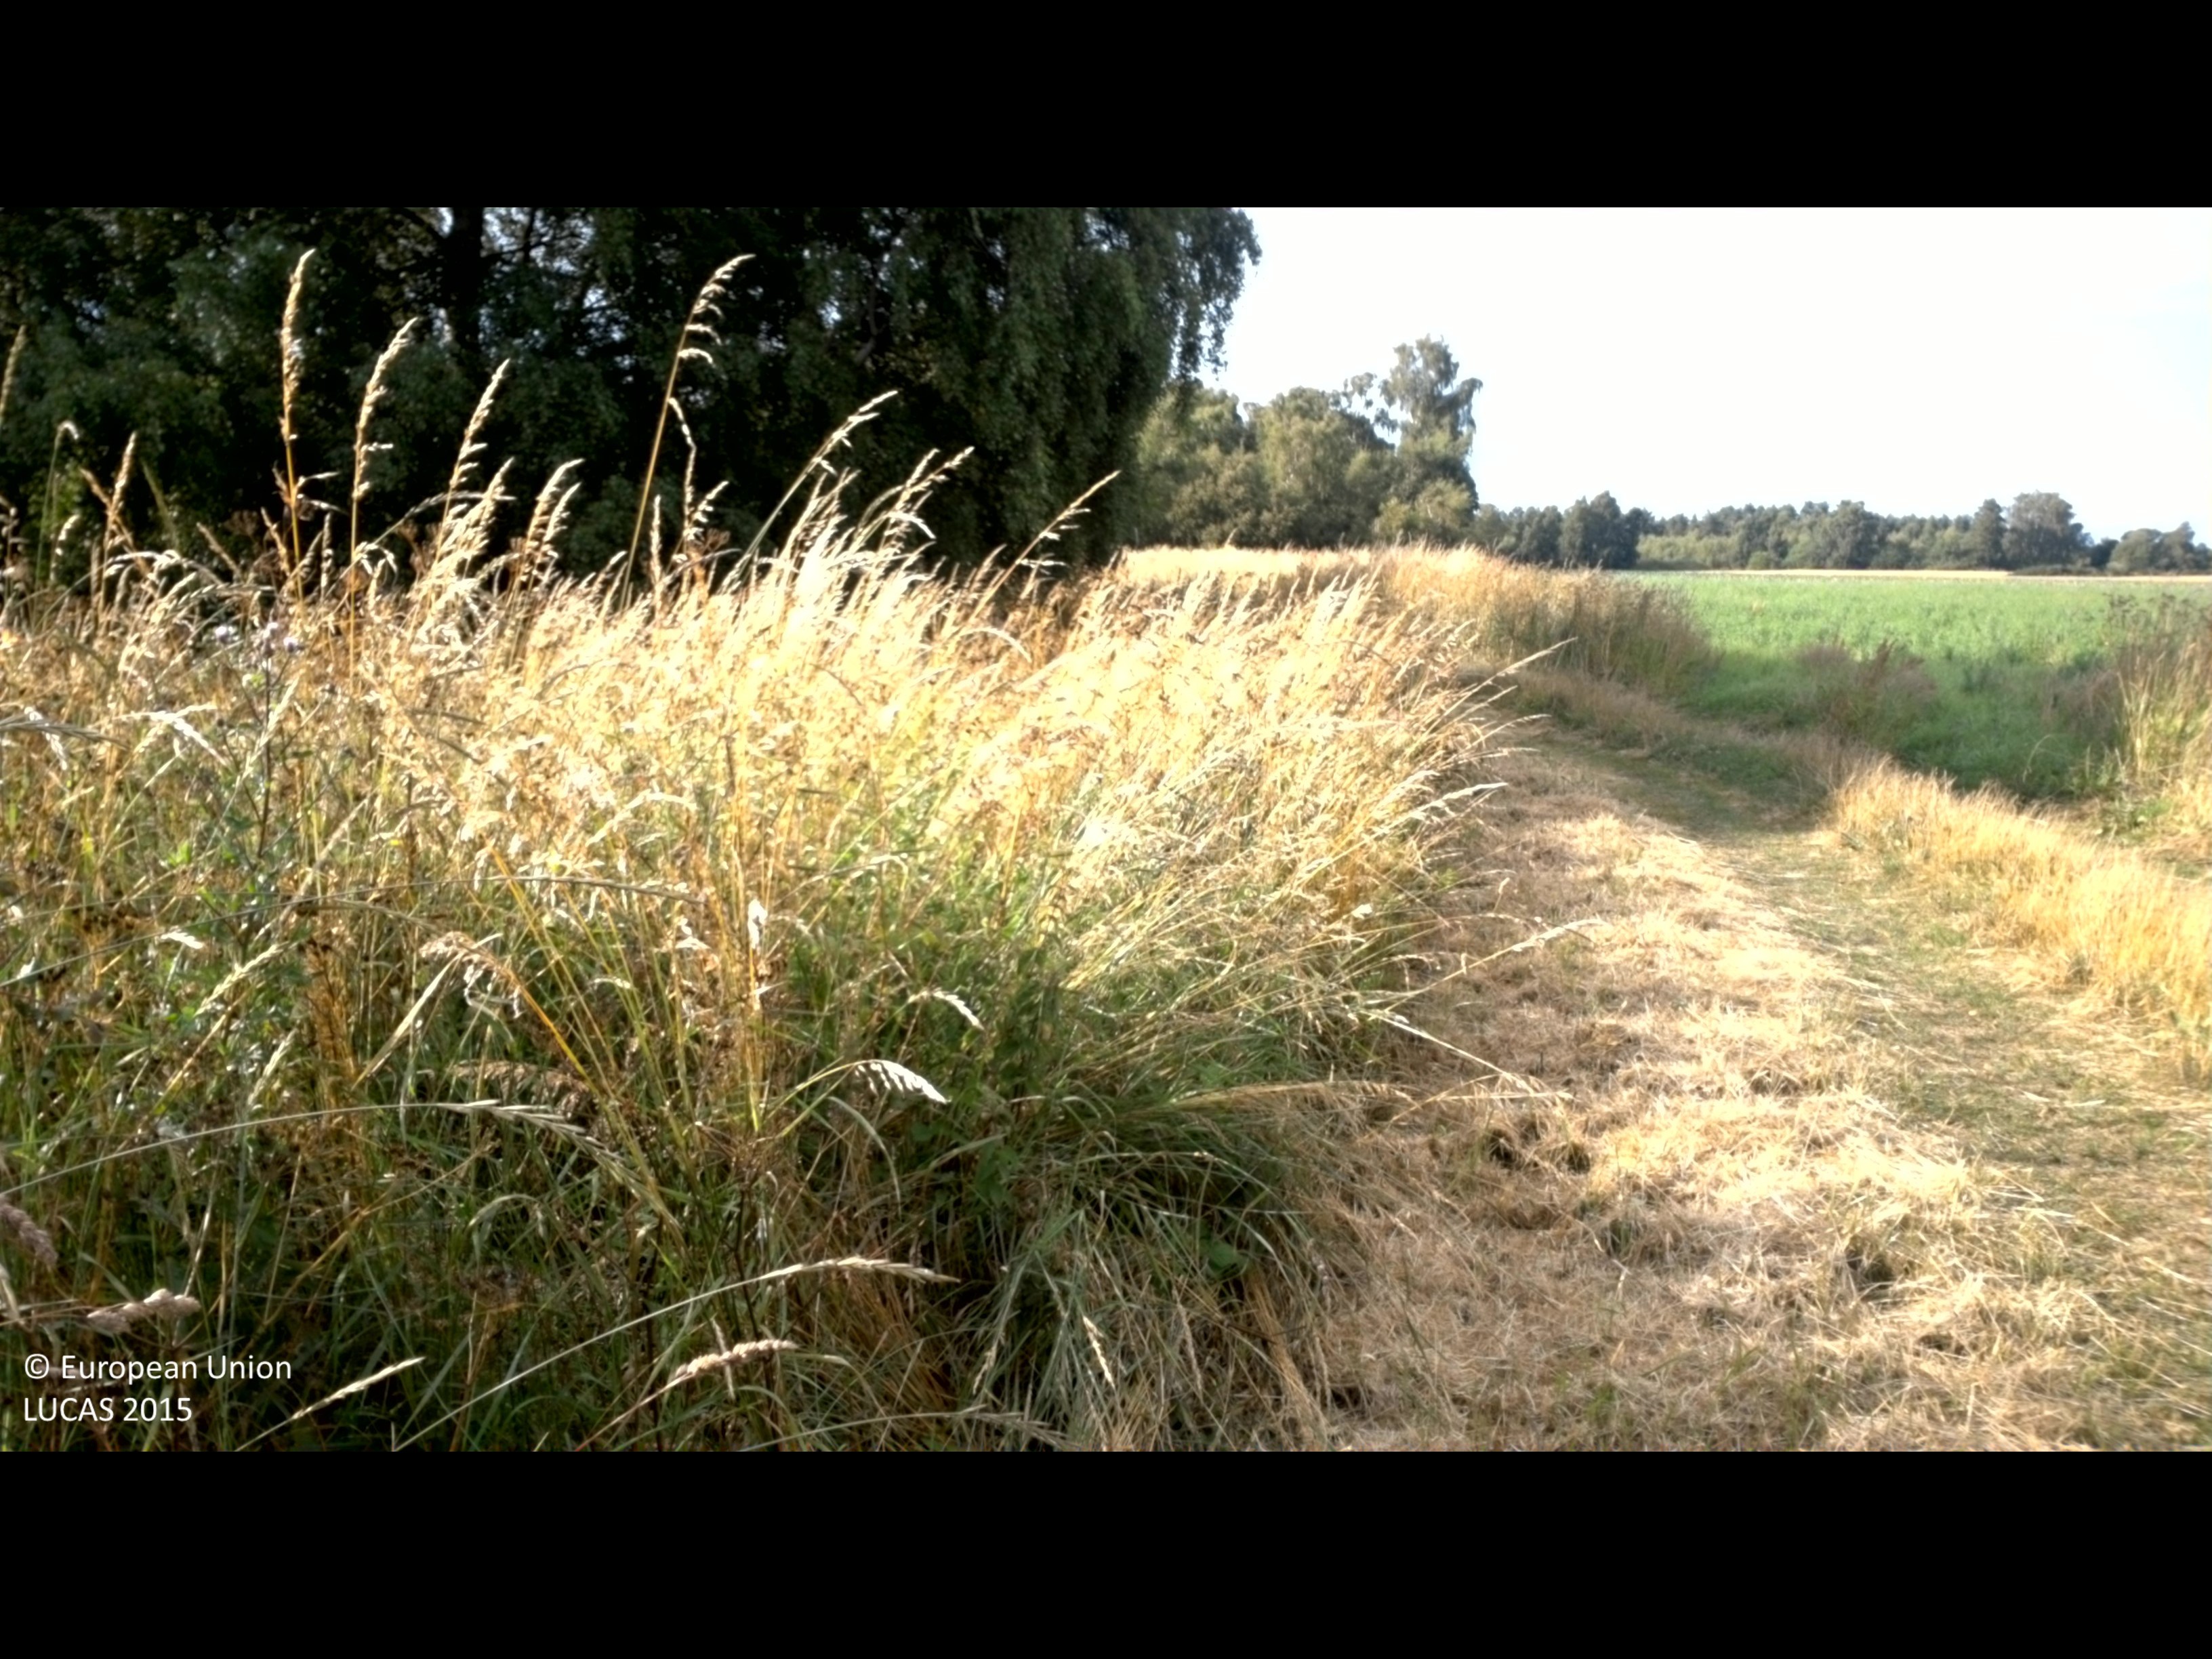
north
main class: Shrubland
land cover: Shrubland without tree cover
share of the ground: > 75 %
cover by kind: shrubs 80 %, herbaceous plants 20 %
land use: Semi-natural and natural areas not in use
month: July
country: SE
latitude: 56.5515
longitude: 16.3944
